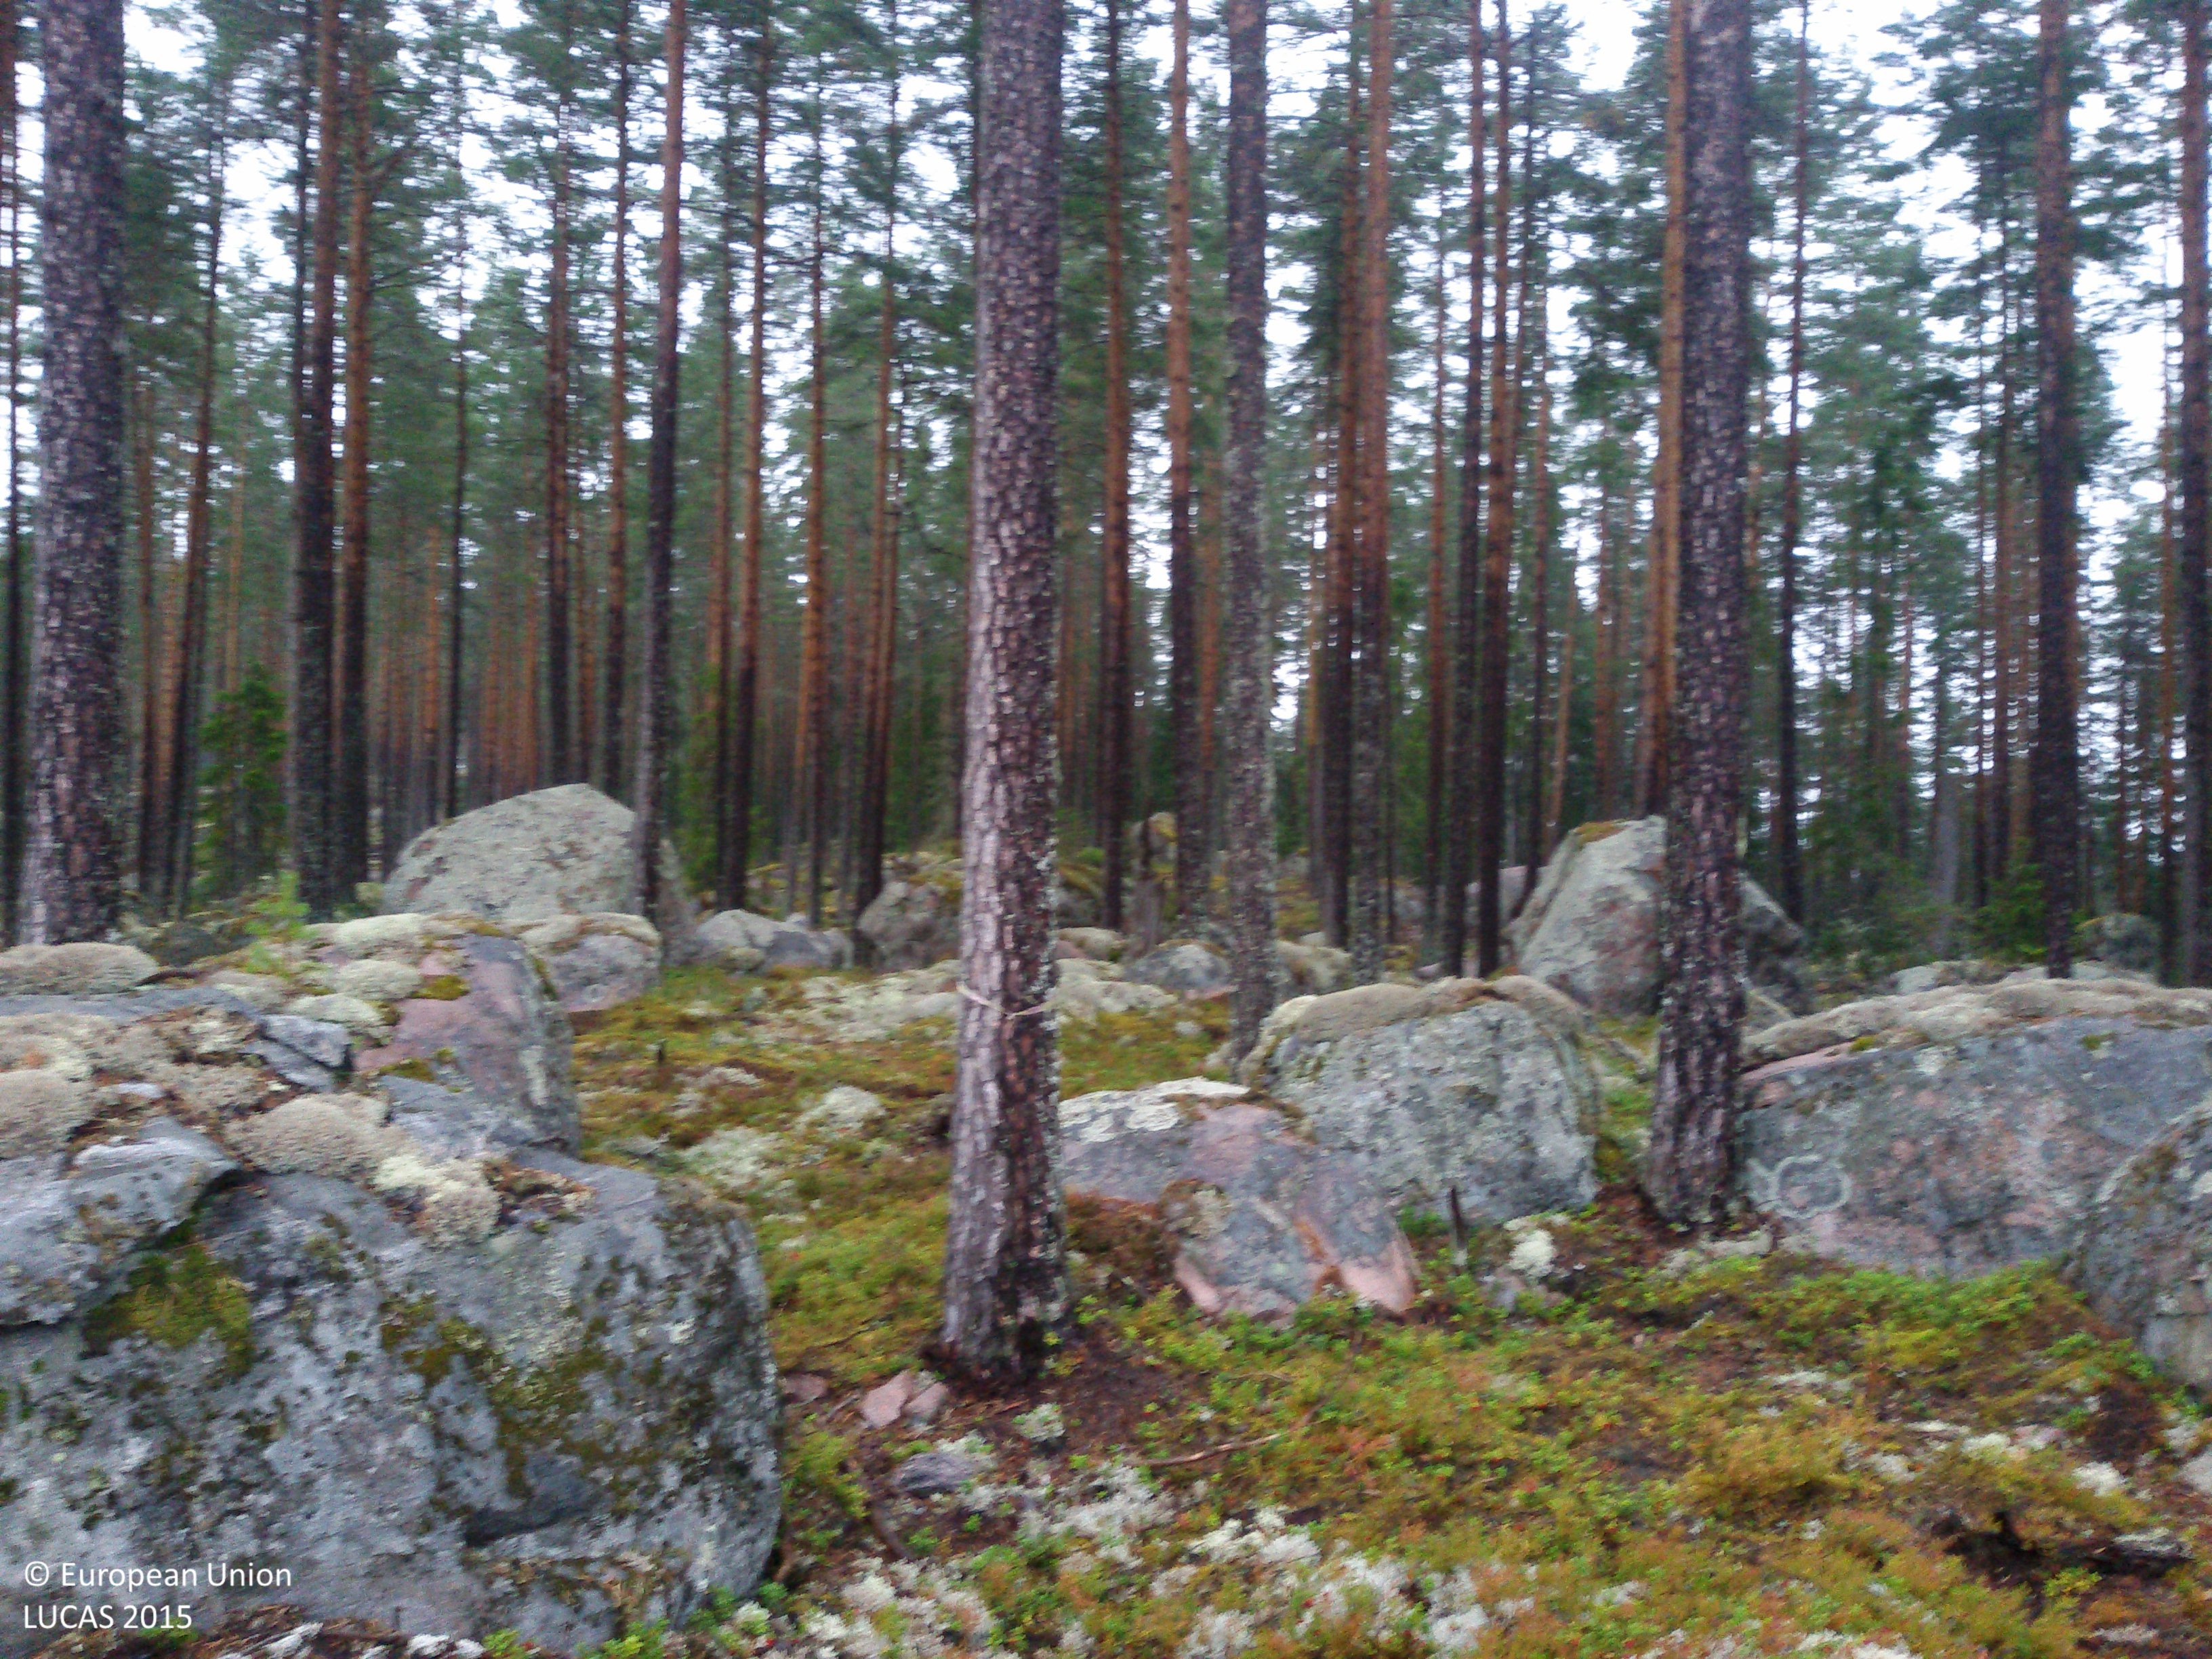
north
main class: Woodland
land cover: Pine dominated coniferous woodland
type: boreal forest
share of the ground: 10 - 25 %
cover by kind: herbaceous plants 40 %, lichens and mosses 40 %, coniferous forest trees 15 %, broadleaved forest trees 5 %
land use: Forestry
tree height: < 5 m
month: September
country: SE
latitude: 60.9836
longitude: 15.7706
